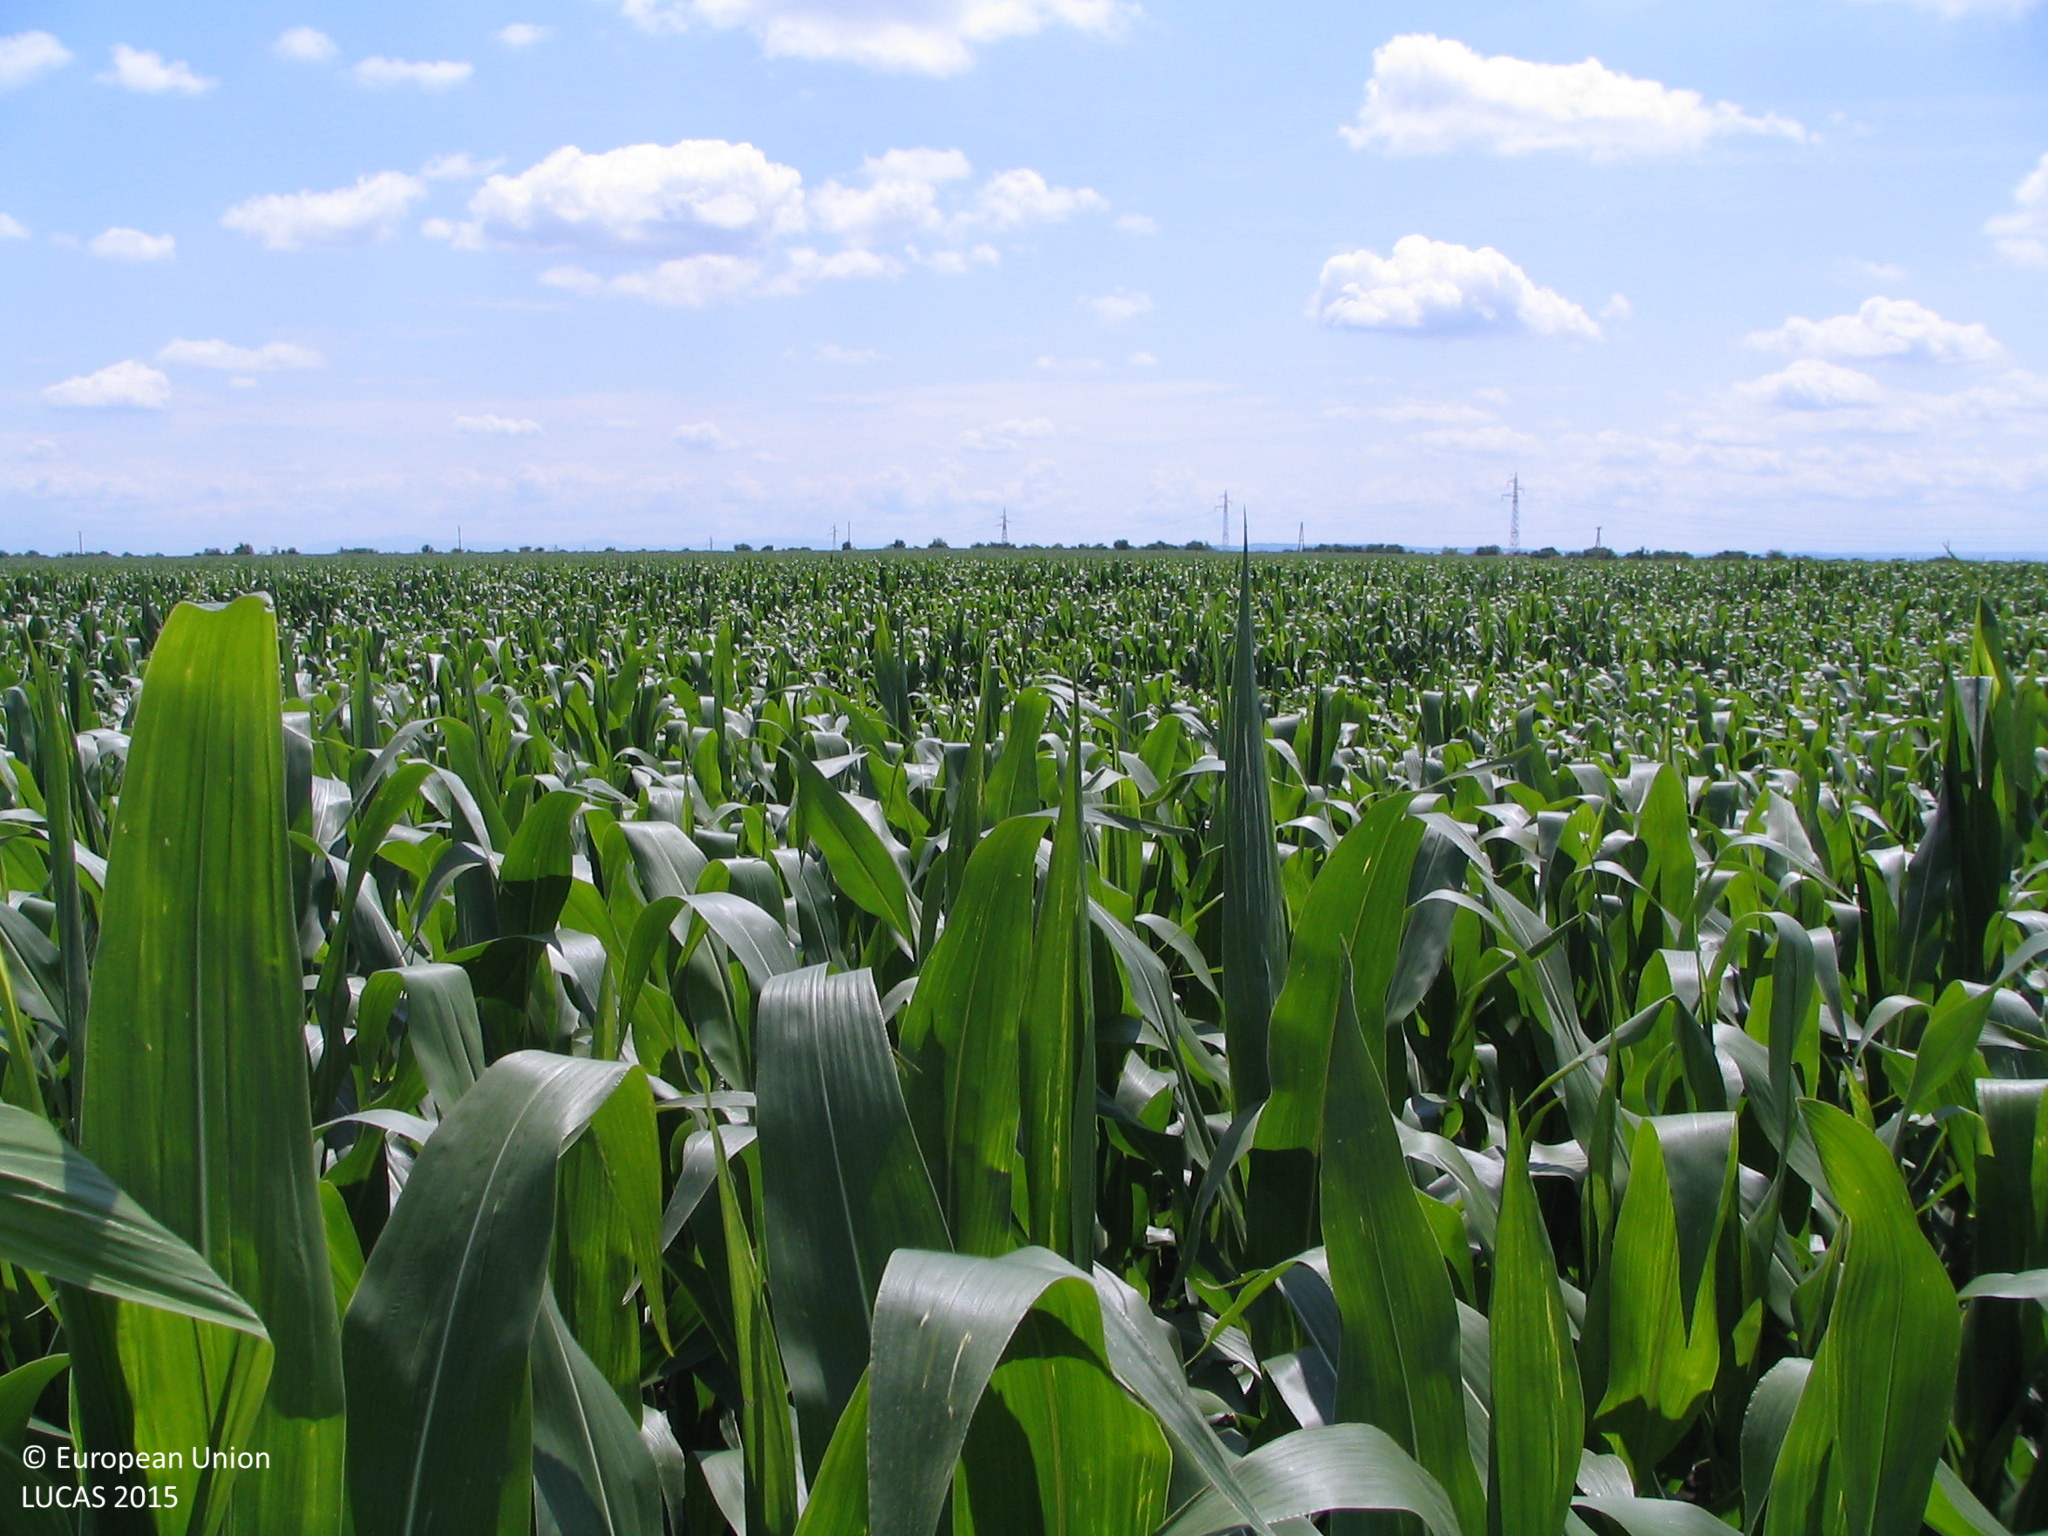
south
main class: Cropland
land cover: Maize
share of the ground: > 75 %
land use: Agriculture (excluding fallow land and kitchen gardens)
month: June
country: BG
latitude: 43.4403
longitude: 24.0768
